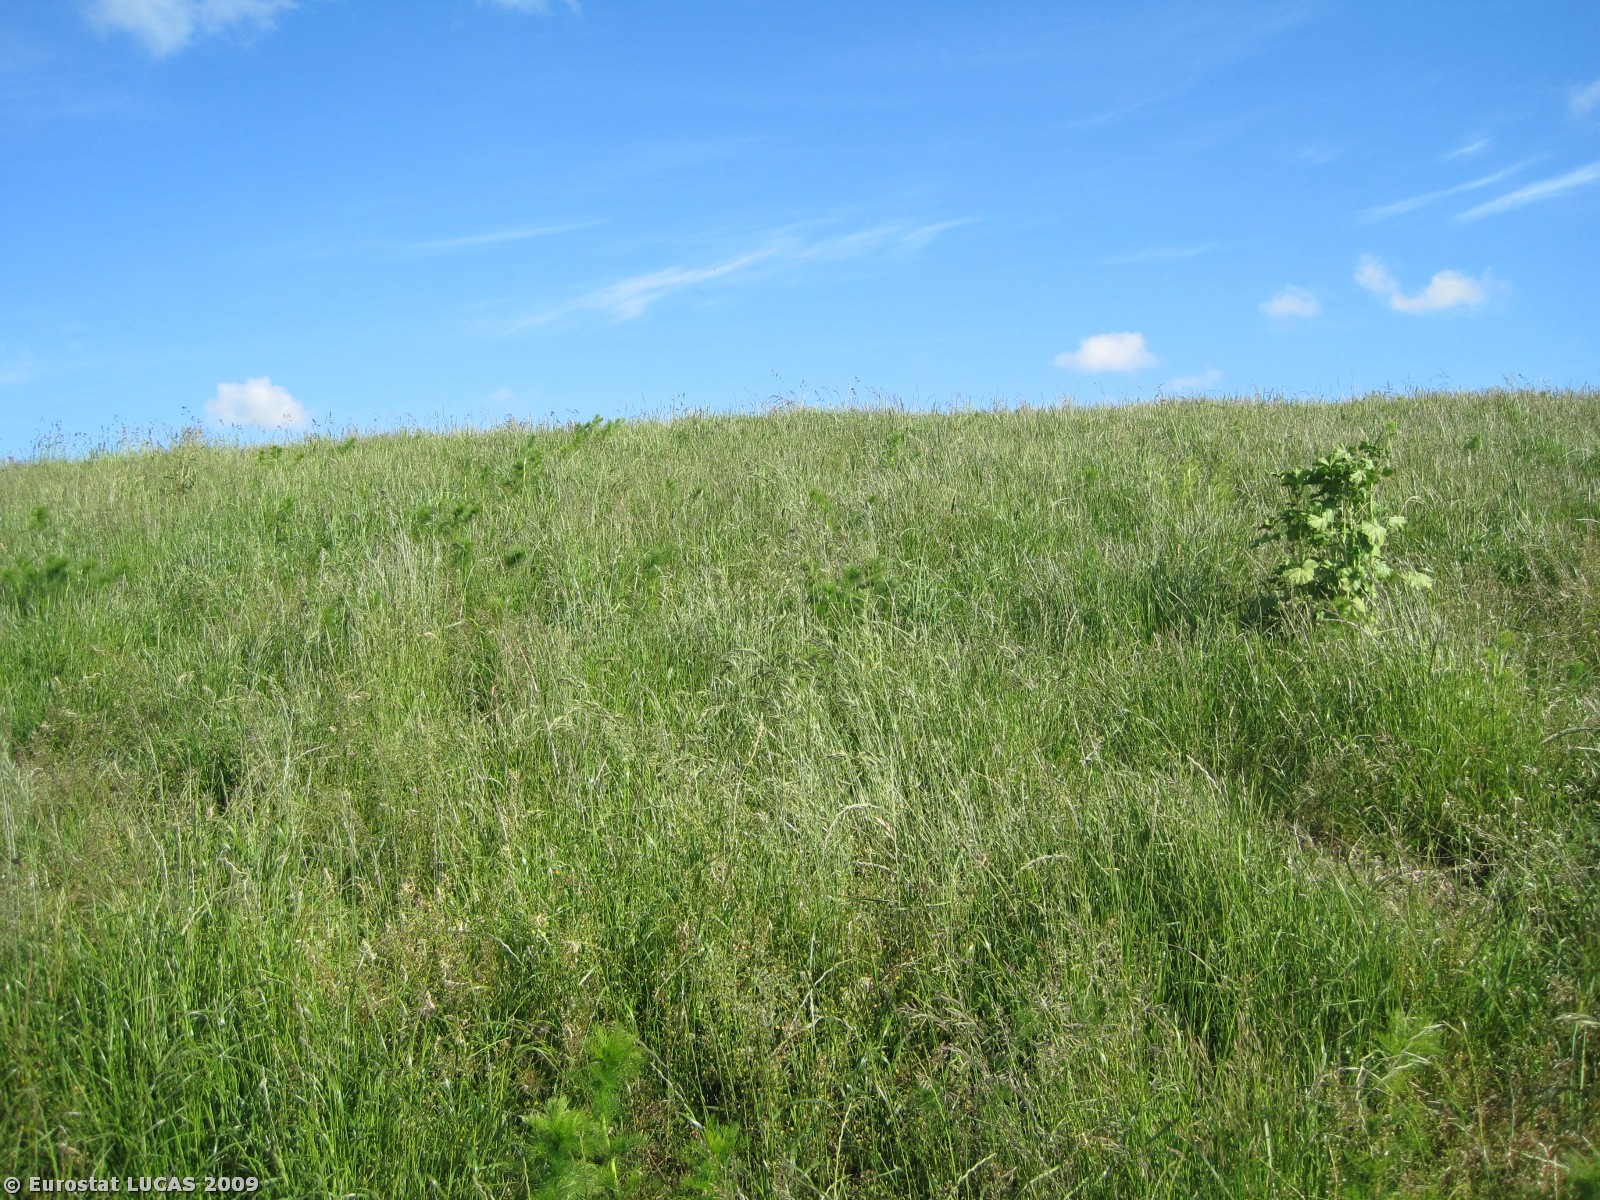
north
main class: Grassland
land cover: Grassland without tree/shrub cover
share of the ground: > 75 %
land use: Agriculture (excluding fallow land and kitchen gardens)
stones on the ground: < 10 %
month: June
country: DK
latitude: 57.4461
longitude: 9.8836
